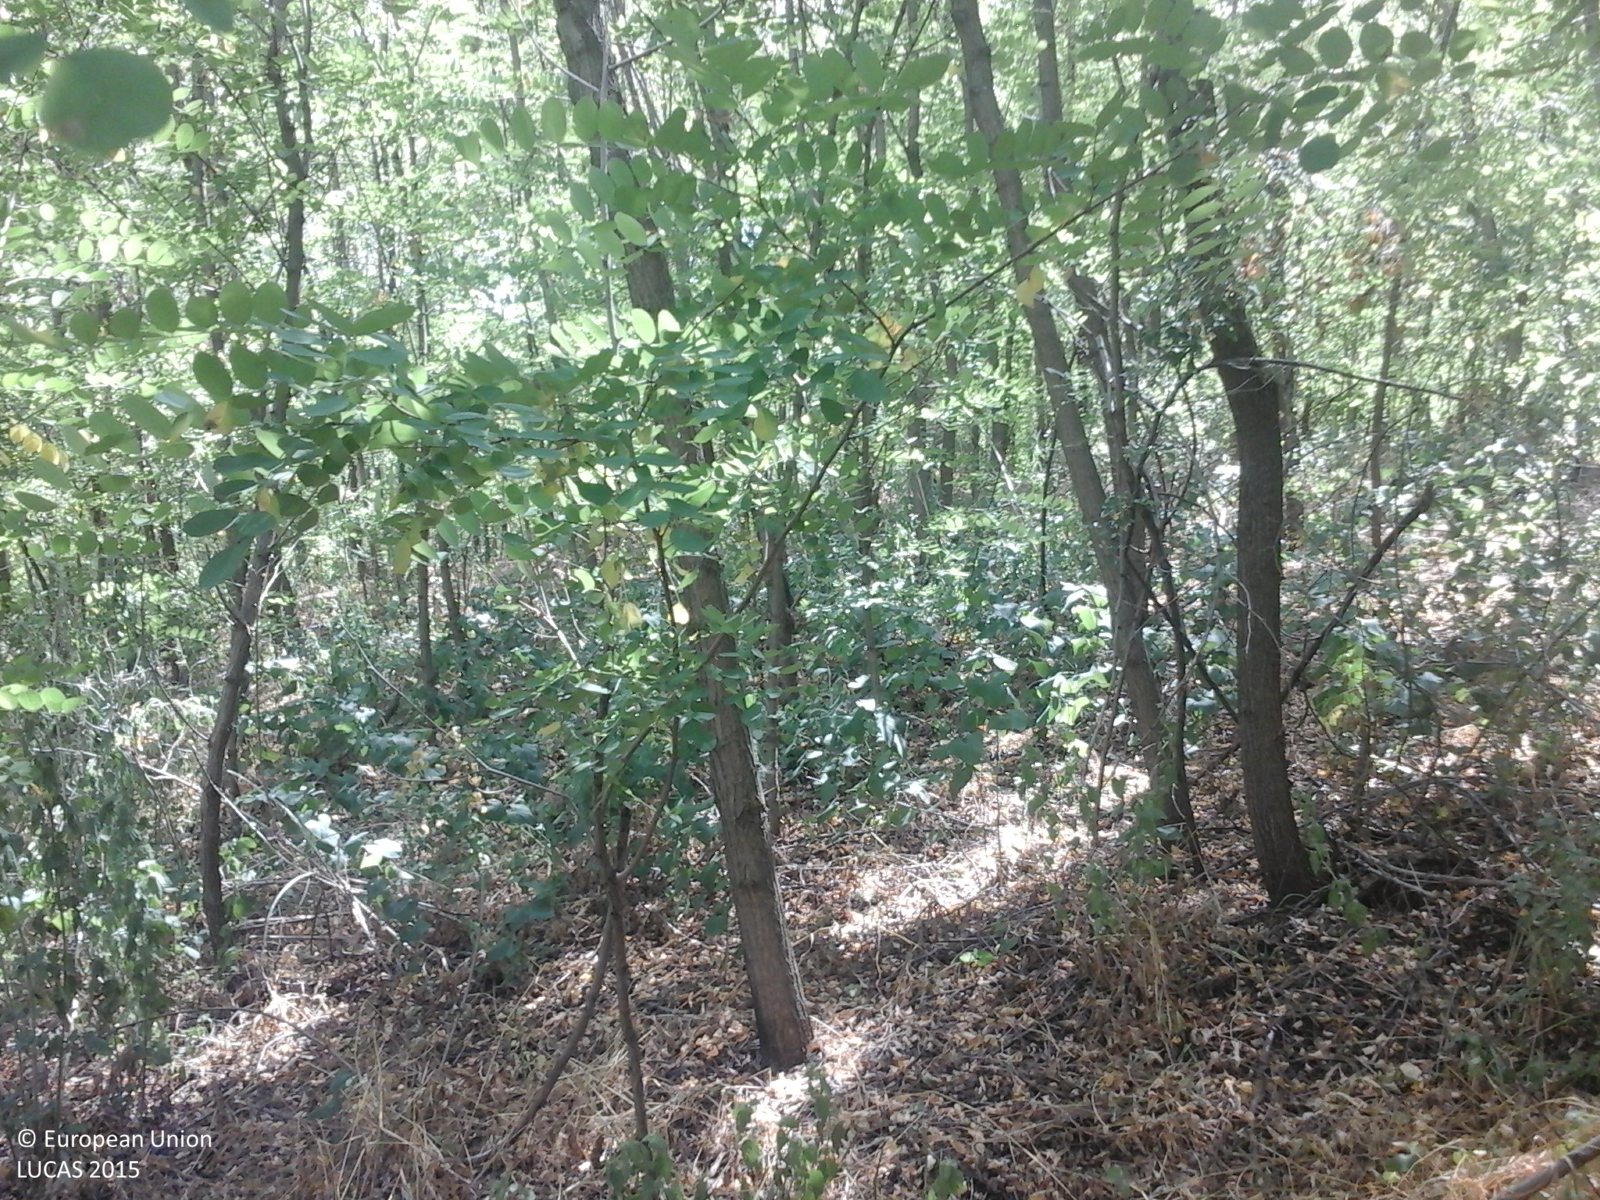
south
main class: Woodland
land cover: Broadleaved woodland
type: exotic forest
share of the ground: > 75 %
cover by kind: broadleaved forest trees 100 %
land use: Forestry
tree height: > 5 m
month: July
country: RO
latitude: 46.5420
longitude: 27.3322
